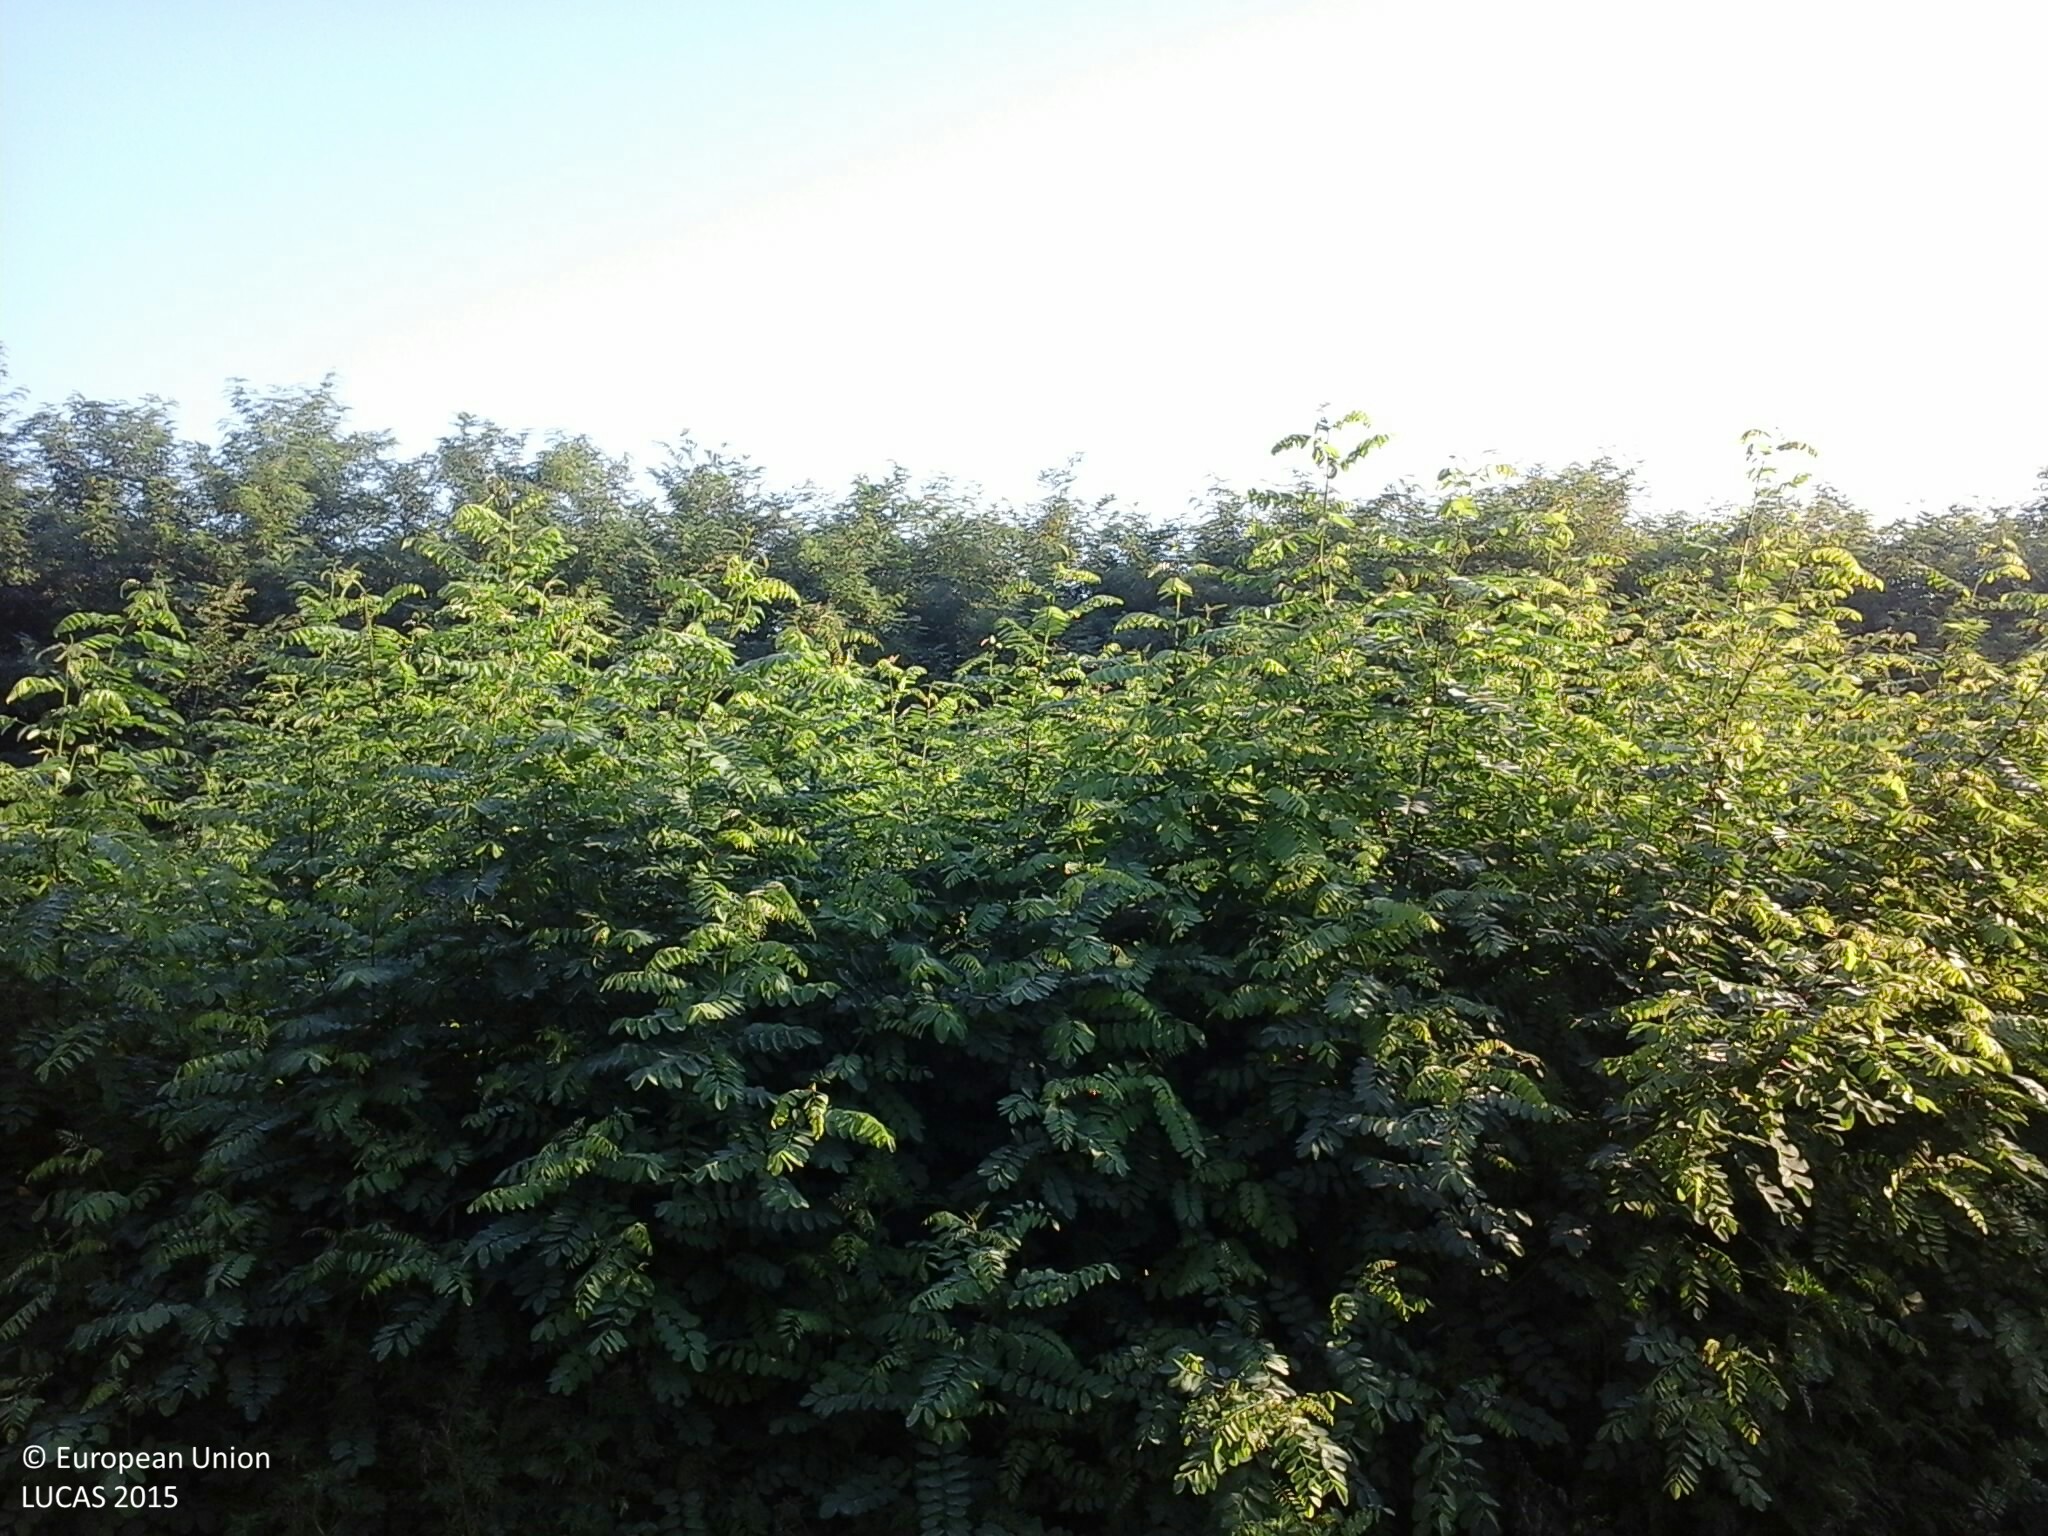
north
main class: Woodland
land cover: Broadleaved woodland
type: exotic forest
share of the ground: 25 - 50 %
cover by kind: unconsolidated bare surface 50 %, broadleaved forest trees 40 %, herbaceous plants 10 %
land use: Forestry
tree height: < 5 m
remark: Nursery
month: July
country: HU
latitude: 47.6985
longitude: 22.1116
